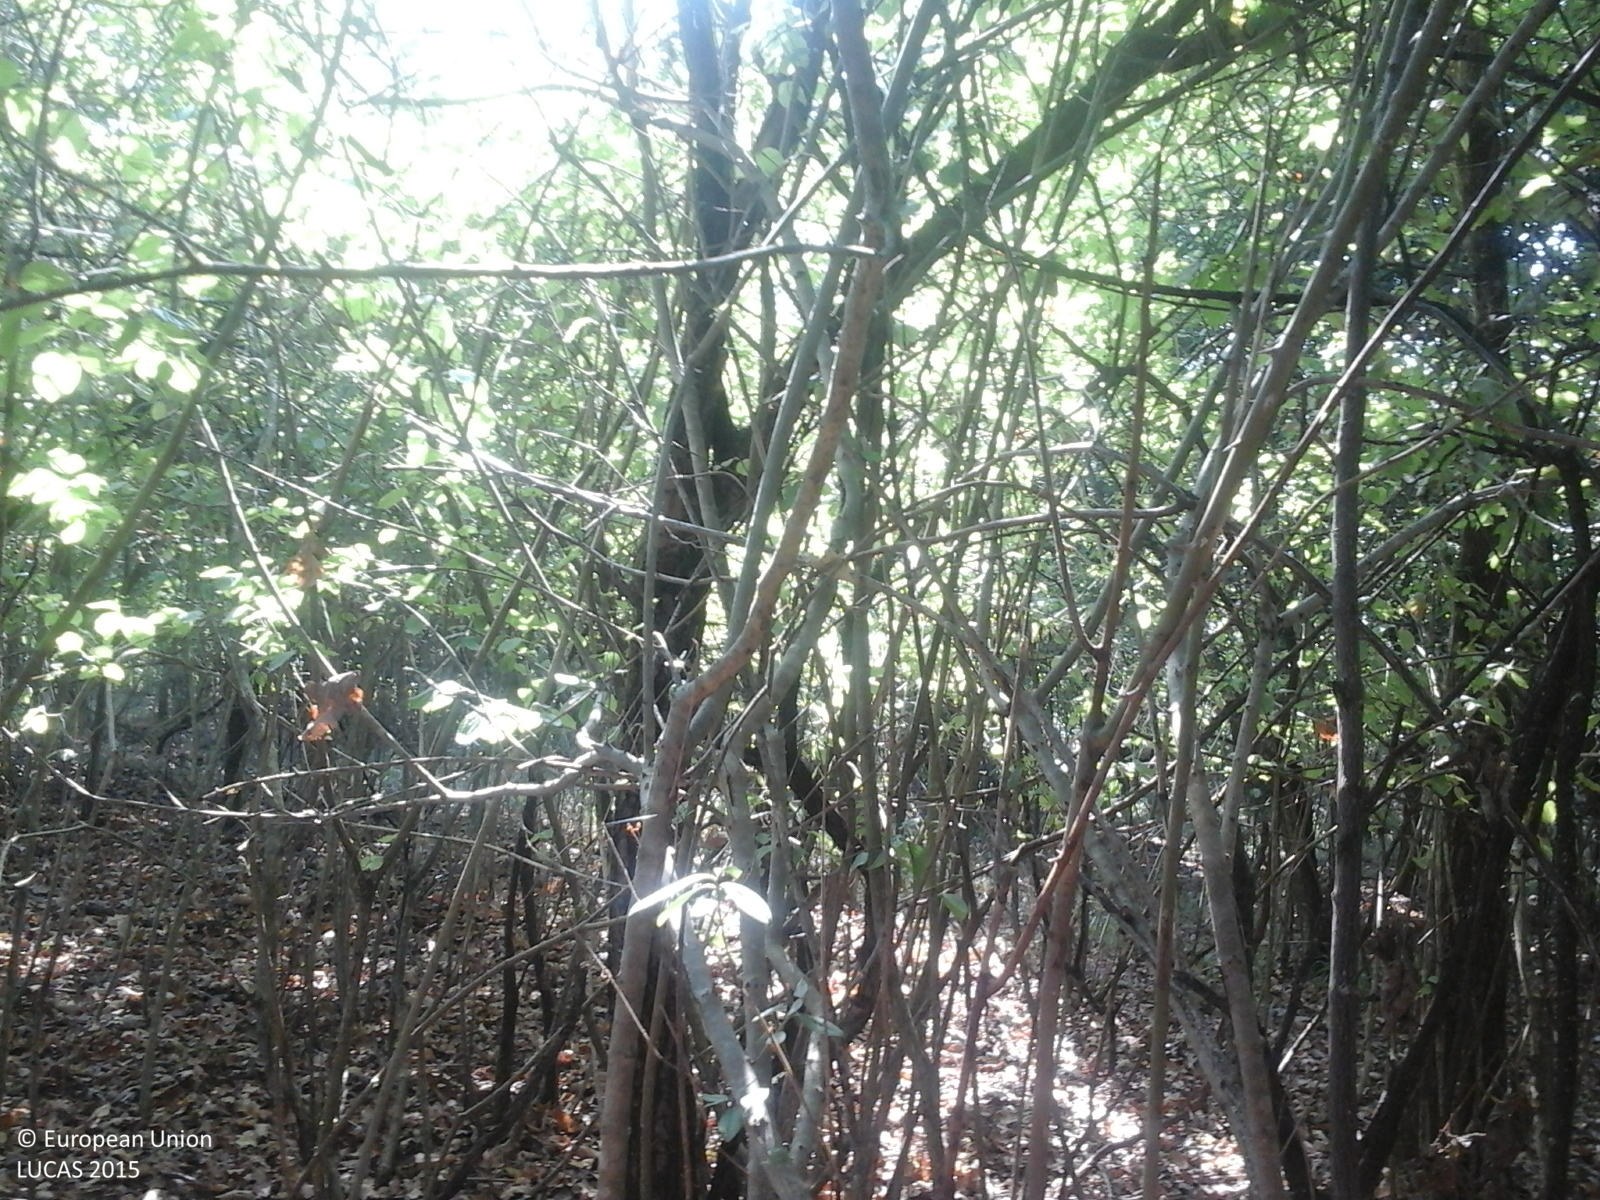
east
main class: Woodland
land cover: Broadleaved woodland
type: acidophilous oak and oak-birch forest
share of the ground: > 75 %
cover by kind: broadleaved forest trees 100 %
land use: Forestry
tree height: > 5 m
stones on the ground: < 10 %
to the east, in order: Broadleaved woodland; Grass margins; Ditches and canals; Grass margins; Paved roads, cycling and walking lanes; Grass margins; Ditches and canals; Grass margins; Broadleaved woodland; Grassland without tree/shrub cover
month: August
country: RO
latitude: 46.4133
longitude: 22.2108
